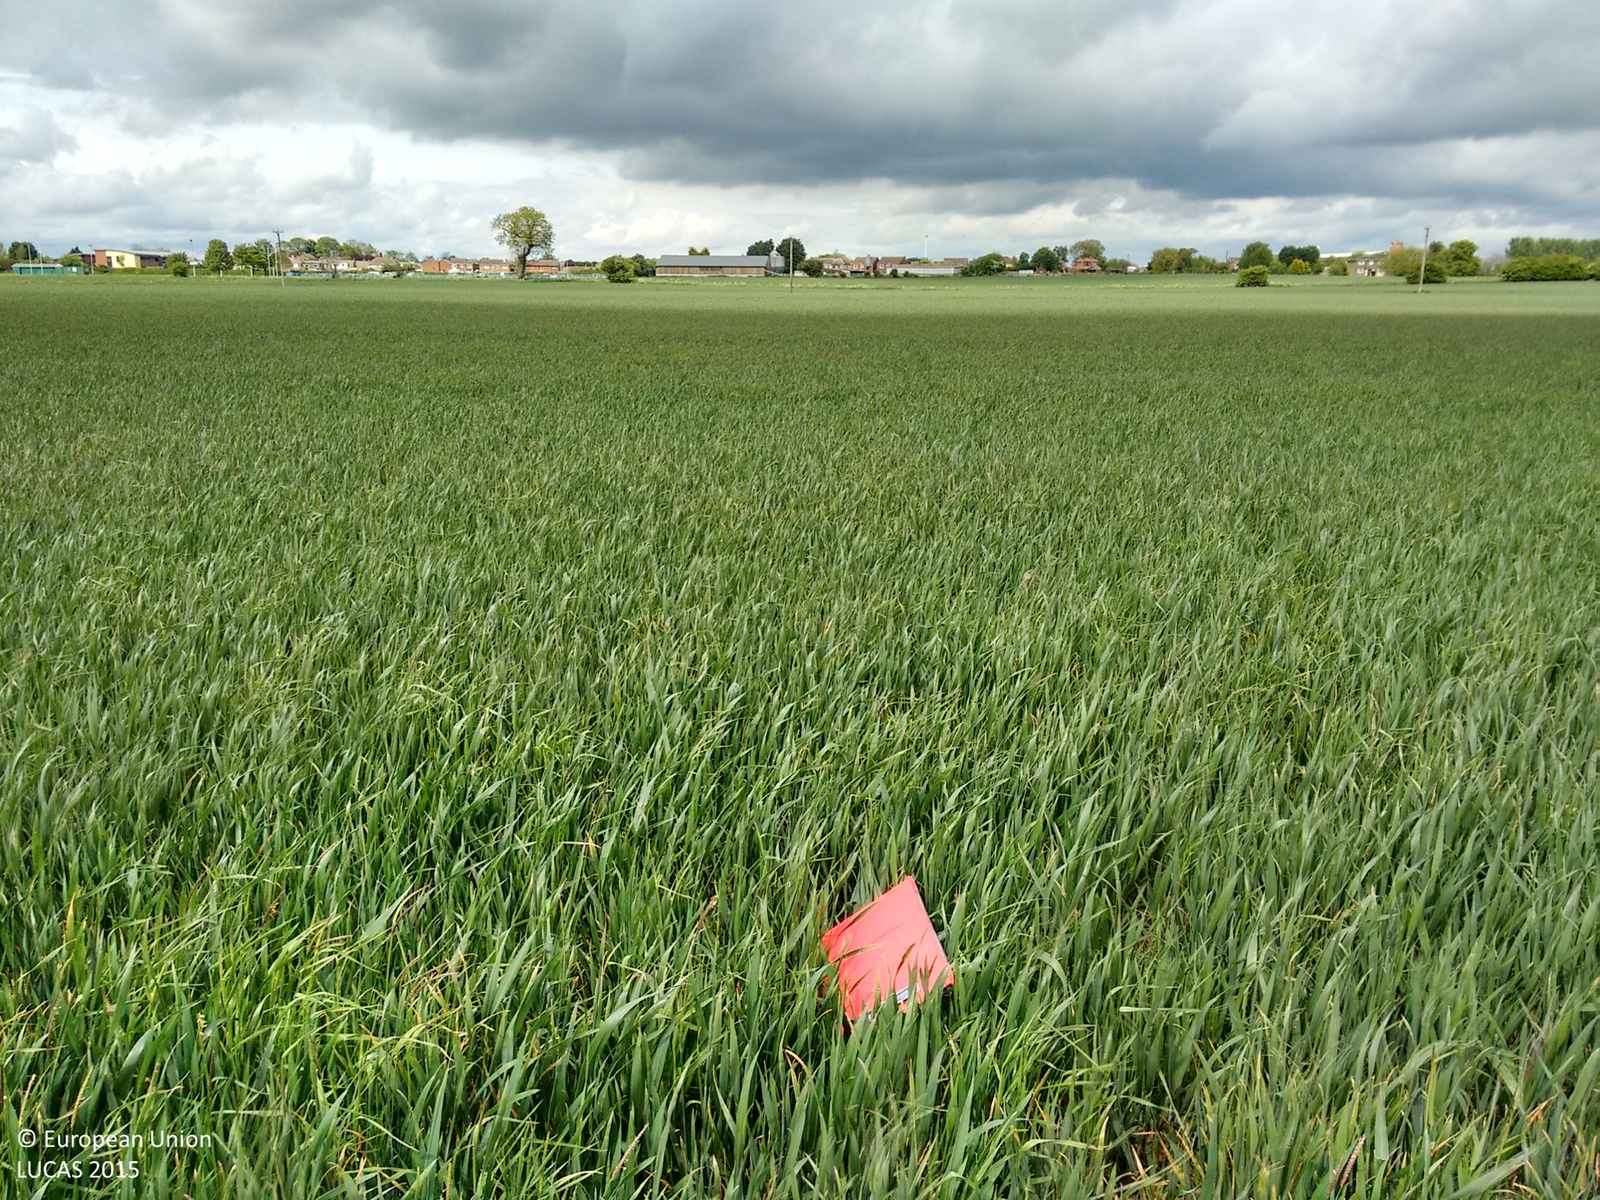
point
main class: Cropland
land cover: Common wheat
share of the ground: > 75 %
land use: Agriculture (excluding fallow land and kitchen gardens)
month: May
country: GB
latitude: 53.7031
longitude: -0.1060
